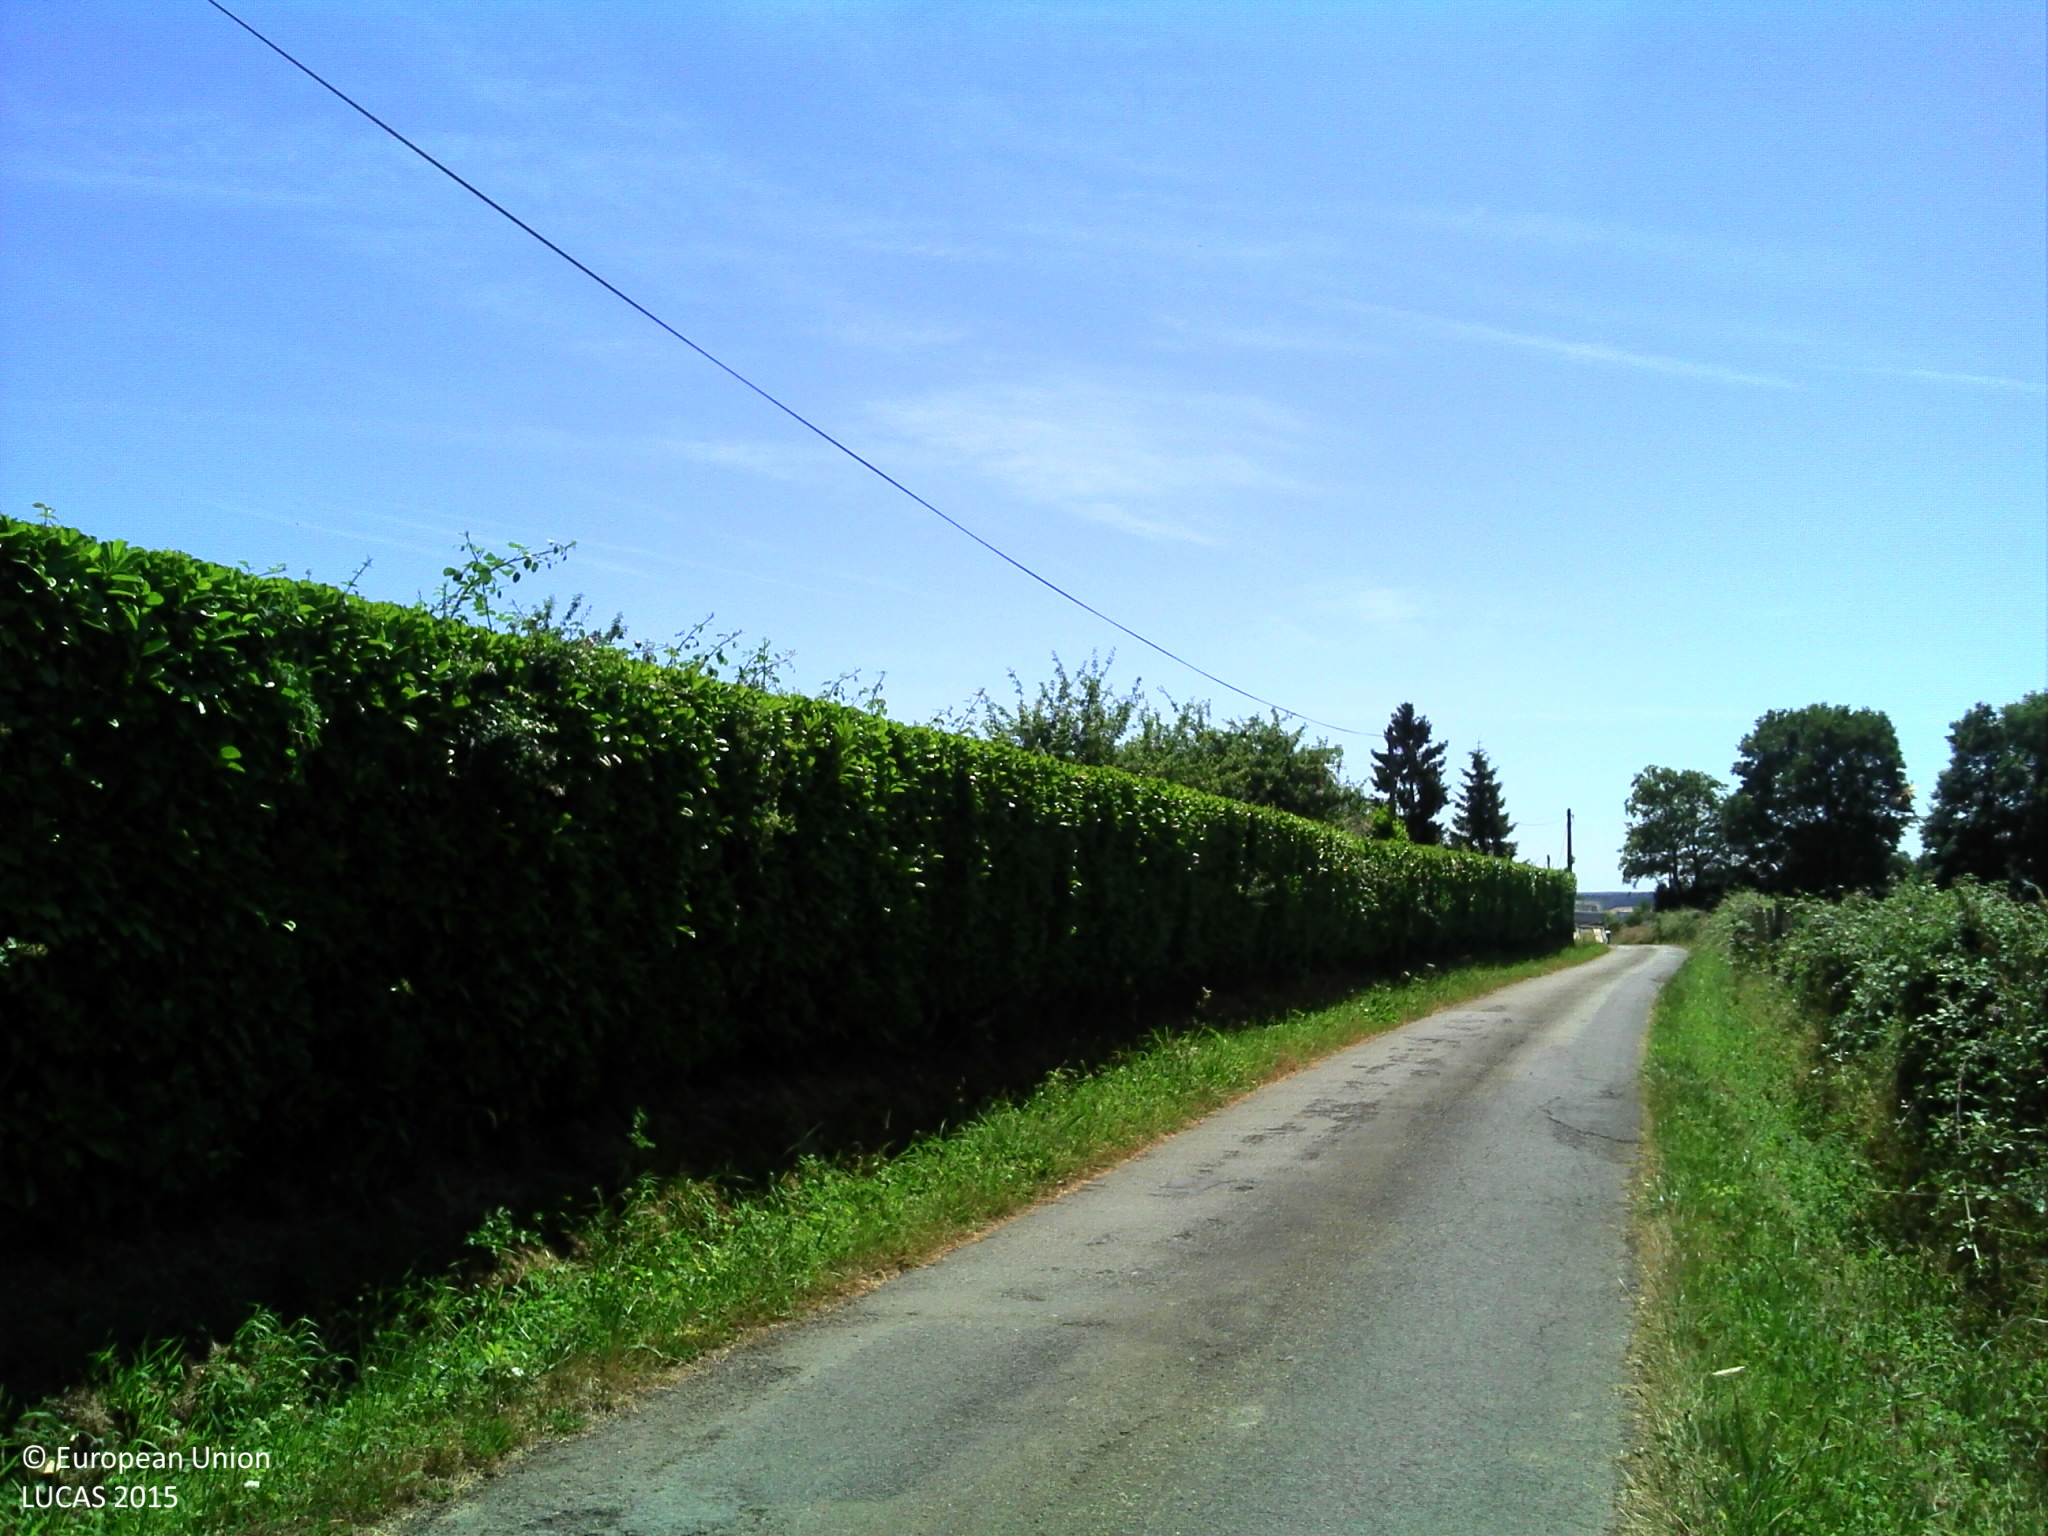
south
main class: Grassland
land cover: Grassland without tree/shrub cover
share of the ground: > 75 %
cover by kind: herbaceous plants 100 %
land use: Agriculture (excluding fallow land and kitchen gardens)
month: July
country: FR
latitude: 48.1859
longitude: 0.6289
